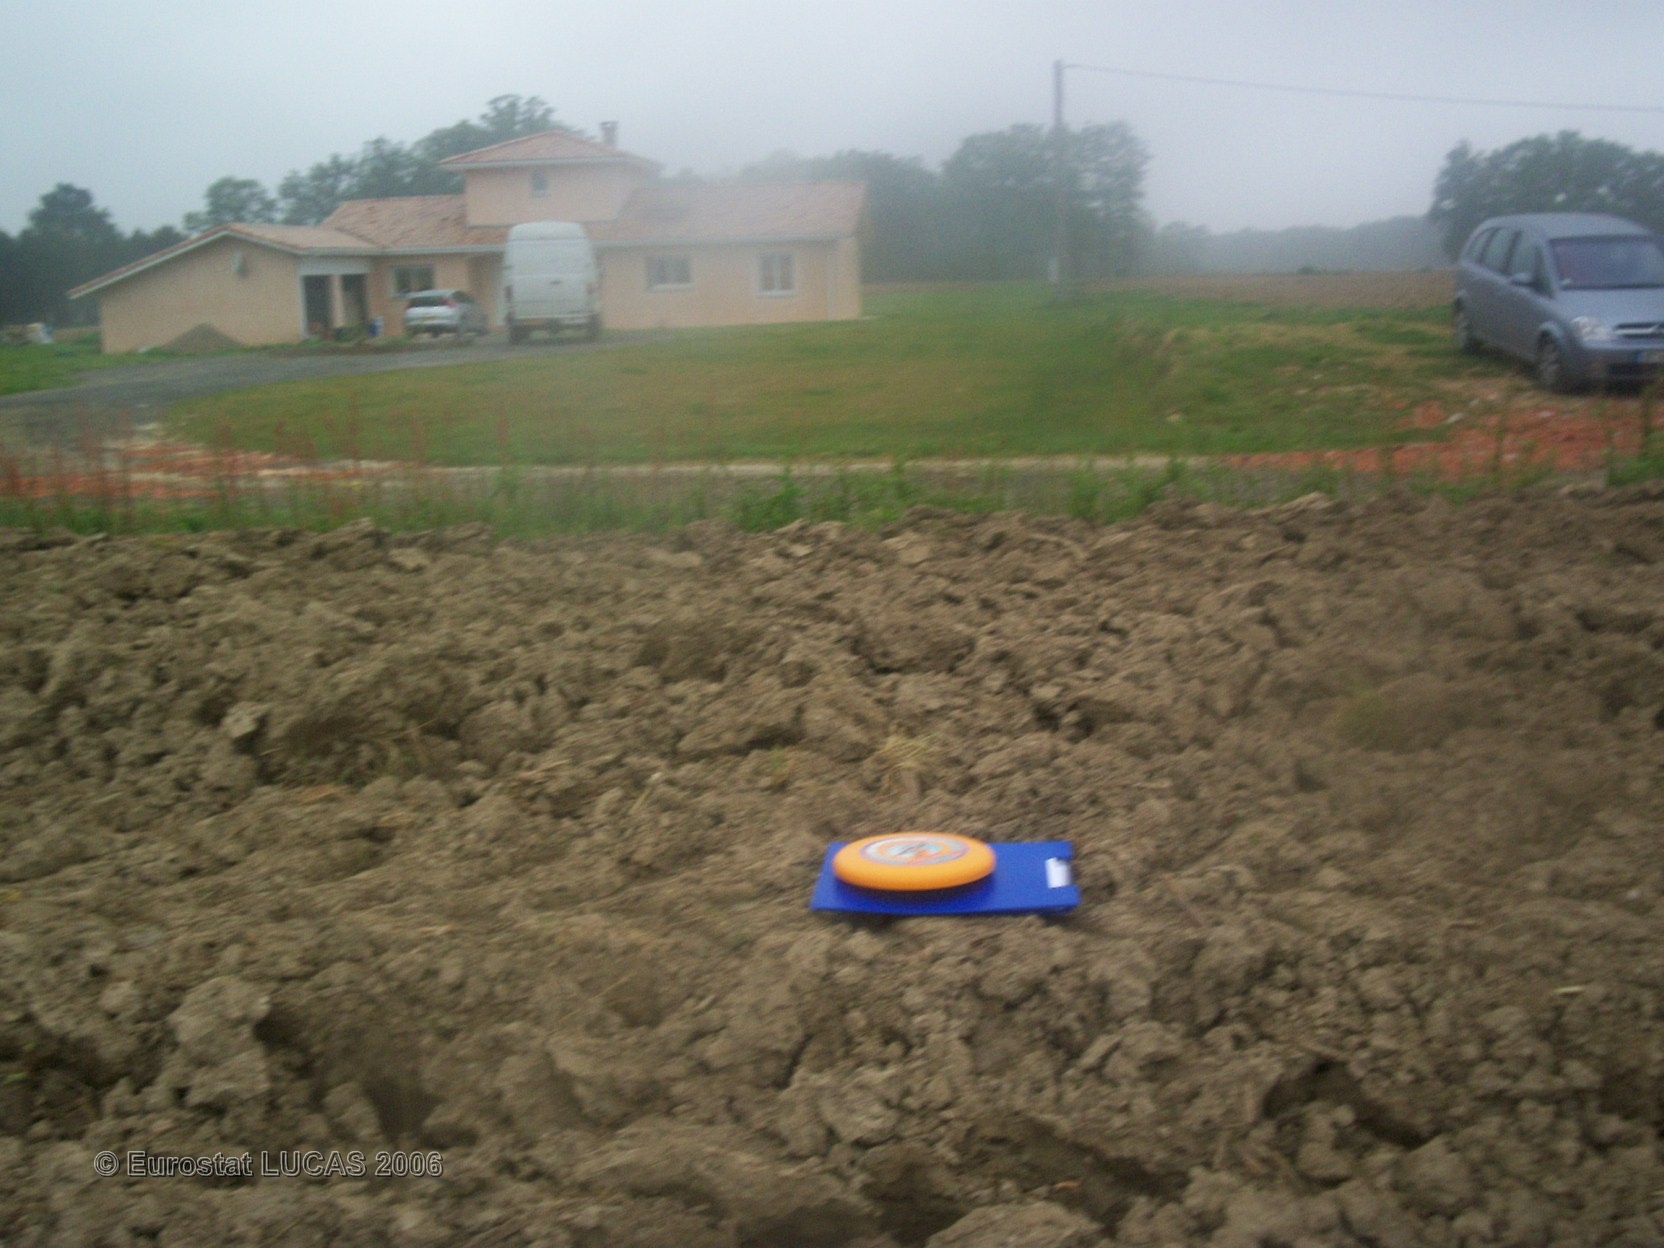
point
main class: Cropland
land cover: Maize
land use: Agriculture (excluding fallow land and kitchen gardens)
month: June
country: FR
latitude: 43.7484
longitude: -0.4545
